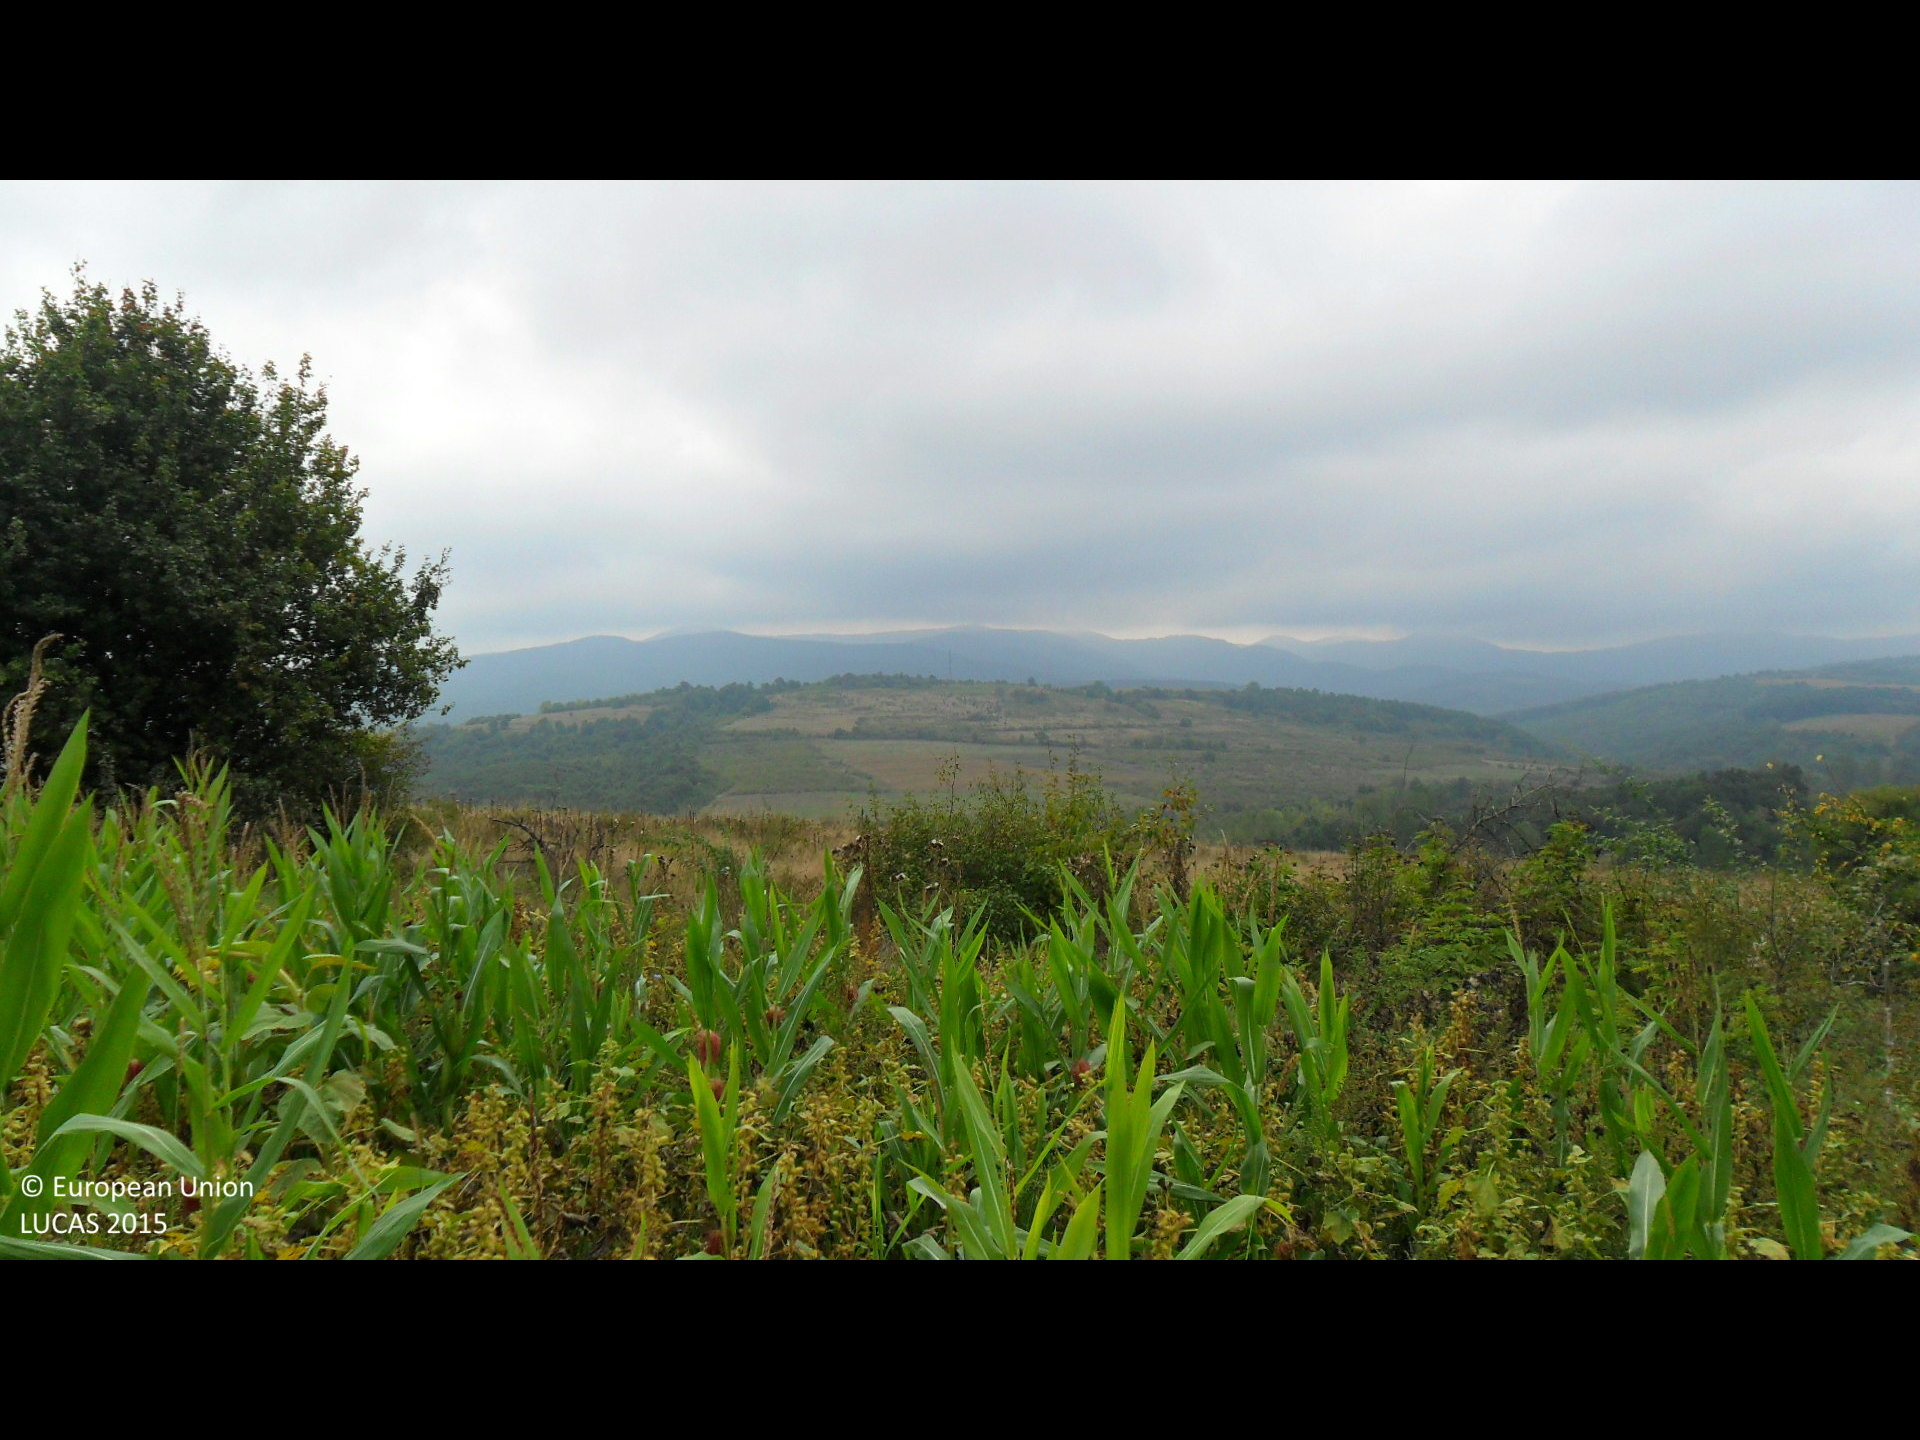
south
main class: Cropland
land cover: Maize
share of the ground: > 75 %
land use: Agriculture (excluding fallow land and kitchen gardens)
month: September
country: BG
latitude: 43.0805
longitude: 26.3460
